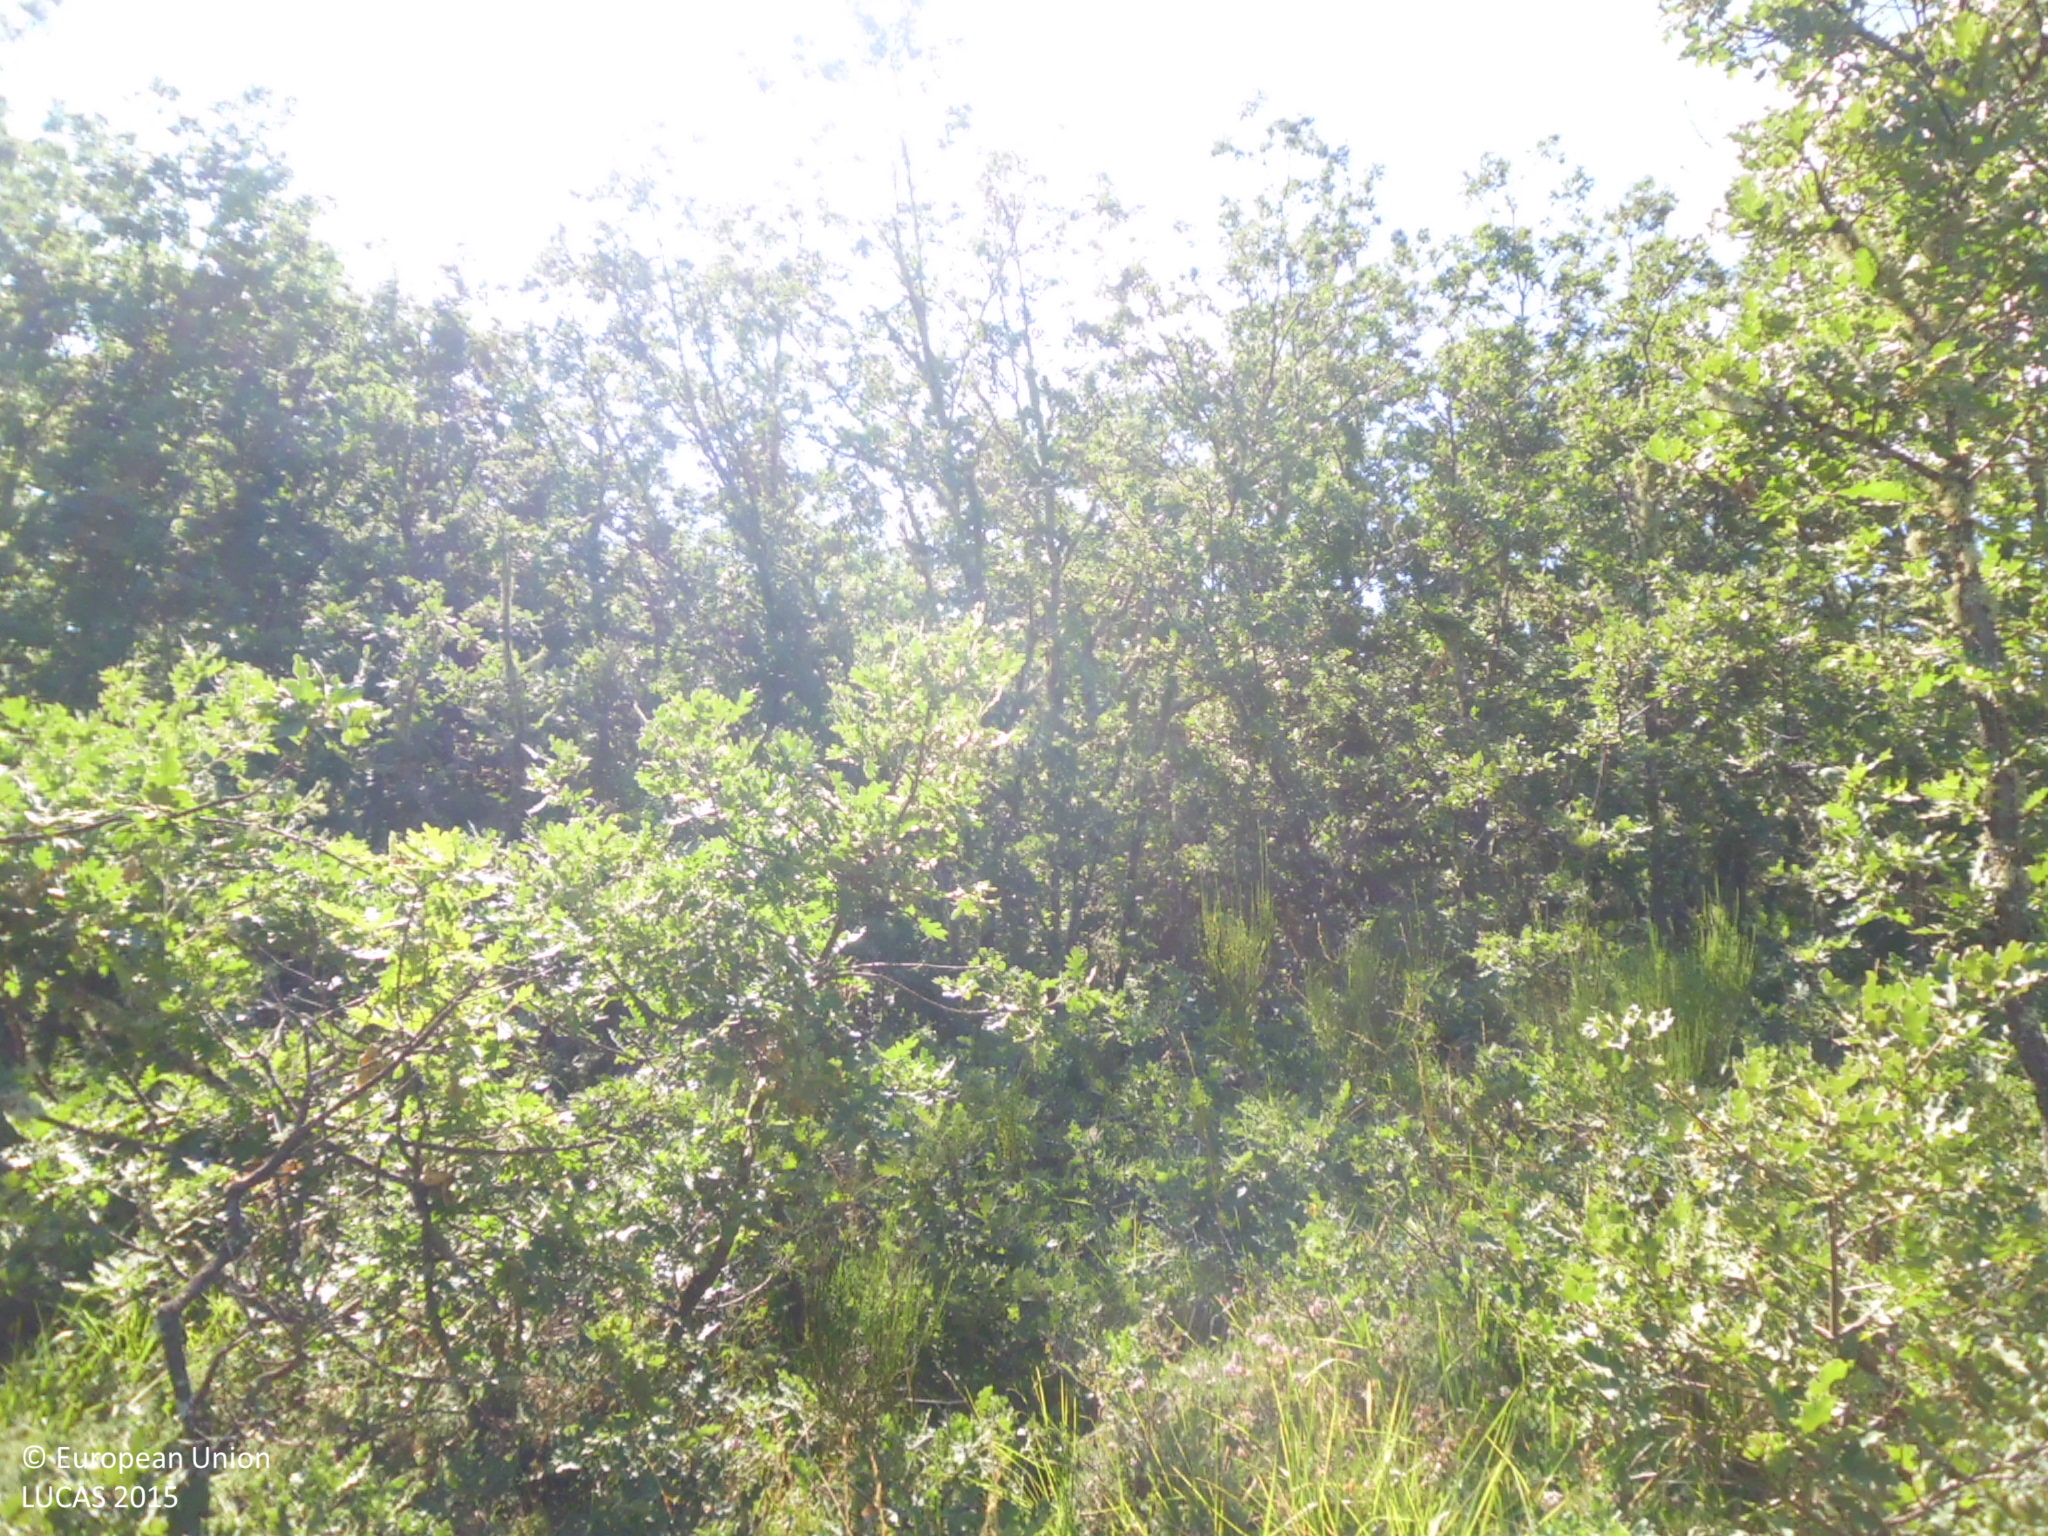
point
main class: Woodland
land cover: Broadleaved woodland
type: acidophilous oak and oak-birch forest
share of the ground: > 75 %
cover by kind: broadleaved forest trees 90 %, shrubs 10 %
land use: Semi-natural and natural areas not in use
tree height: > 5 m
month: July
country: ES
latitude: 42.8661
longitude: -4.3863
